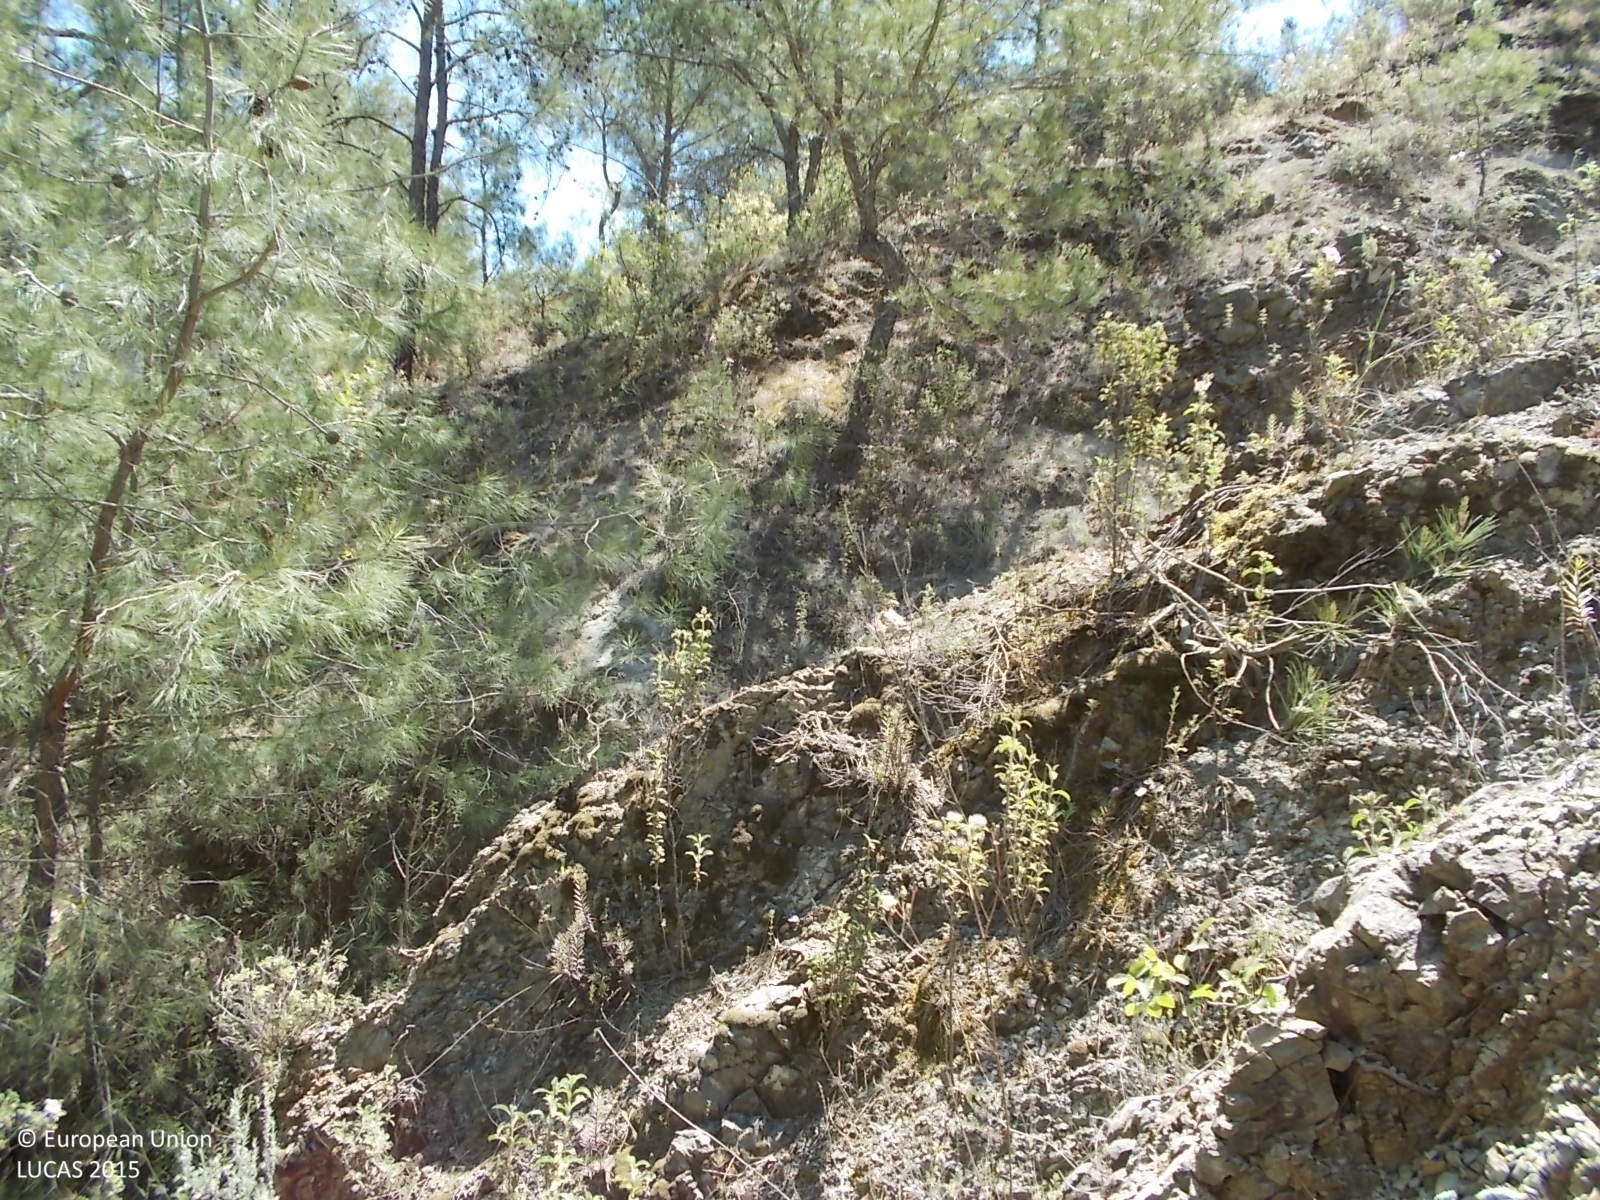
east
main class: Woodland
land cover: Pine dominated coniferous woodland
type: coniferous forest of the mediterranean region
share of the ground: > 75 %
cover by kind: coniferous forest trees 100 %
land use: Amenities, museums, leisure
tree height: > 5 m
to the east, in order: Pine dominated coniferous woodland; Fences; Pine dominated coniferous woodland; Fences; Electric lines; Paved roads, cycling and walking lanes; Pine dominated coniferous woodland; Paved roads, cycling and walking lanes; Grass margins; Other mixed woodland; Tracks; Vineyards; Tracks; Vineyards
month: May
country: CY
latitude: 34.8290
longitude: 33.0097
